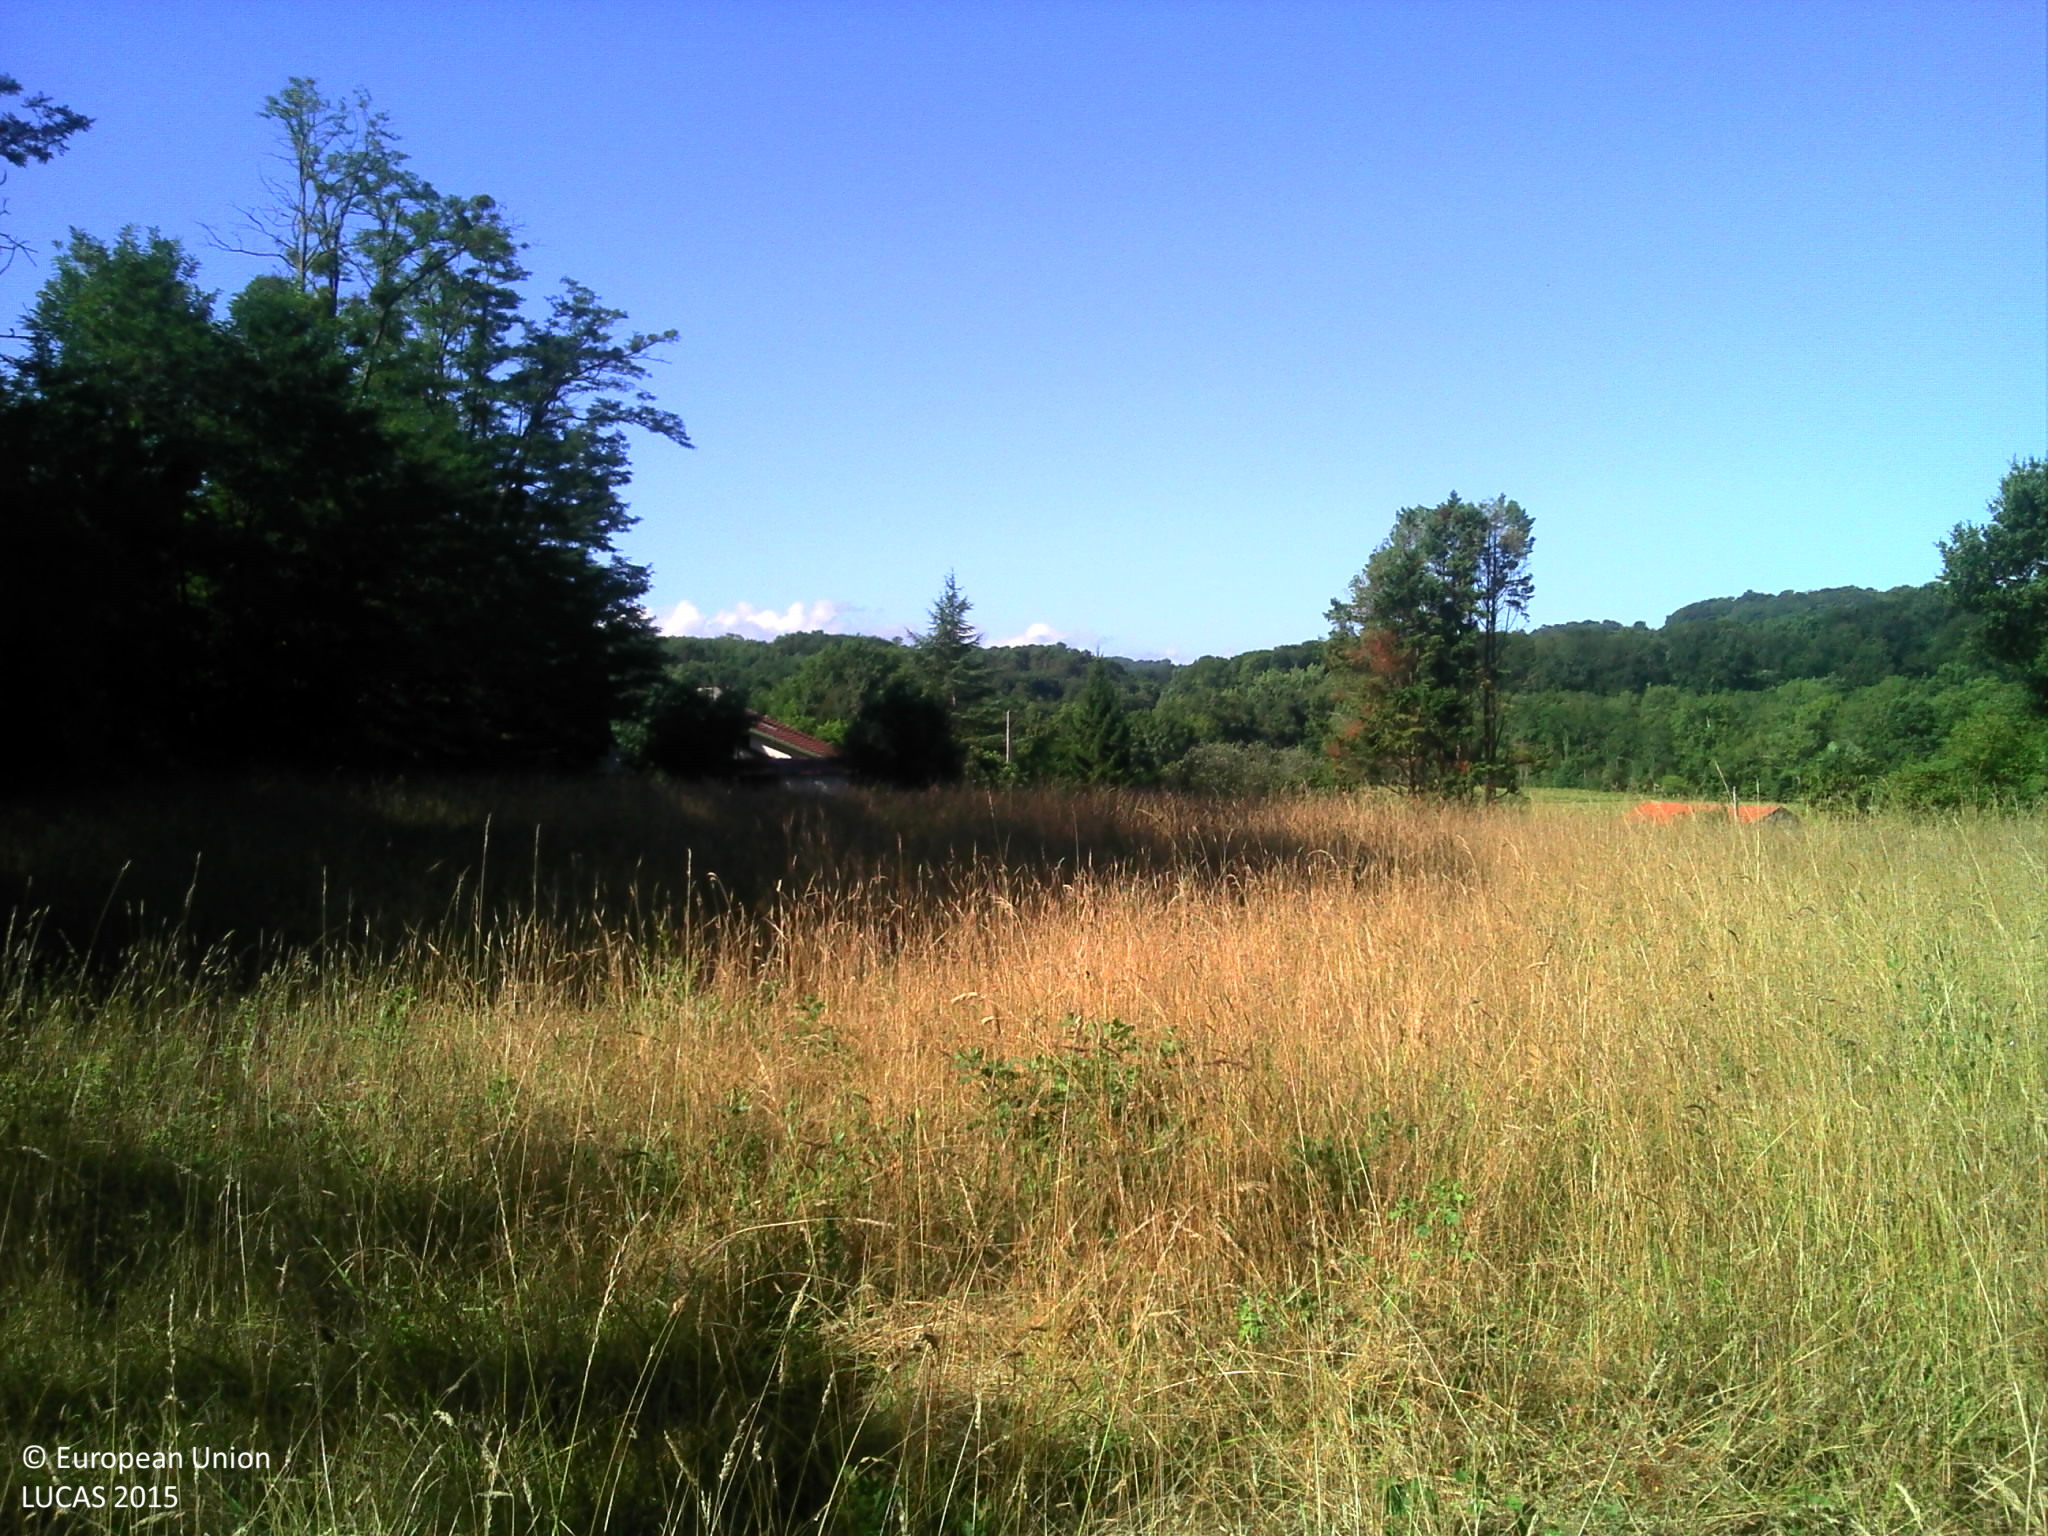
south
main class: Grassland
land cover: Grassland without tree/shrub cover
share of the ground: > 75 %
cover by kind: herbaceous plants 95 %, shrubs 5 %
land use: Agriculture (excluding fallow land and kitchen gardens)
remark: Temporary dry
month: July
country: FR
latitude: 43.6428
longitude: -1.1108
